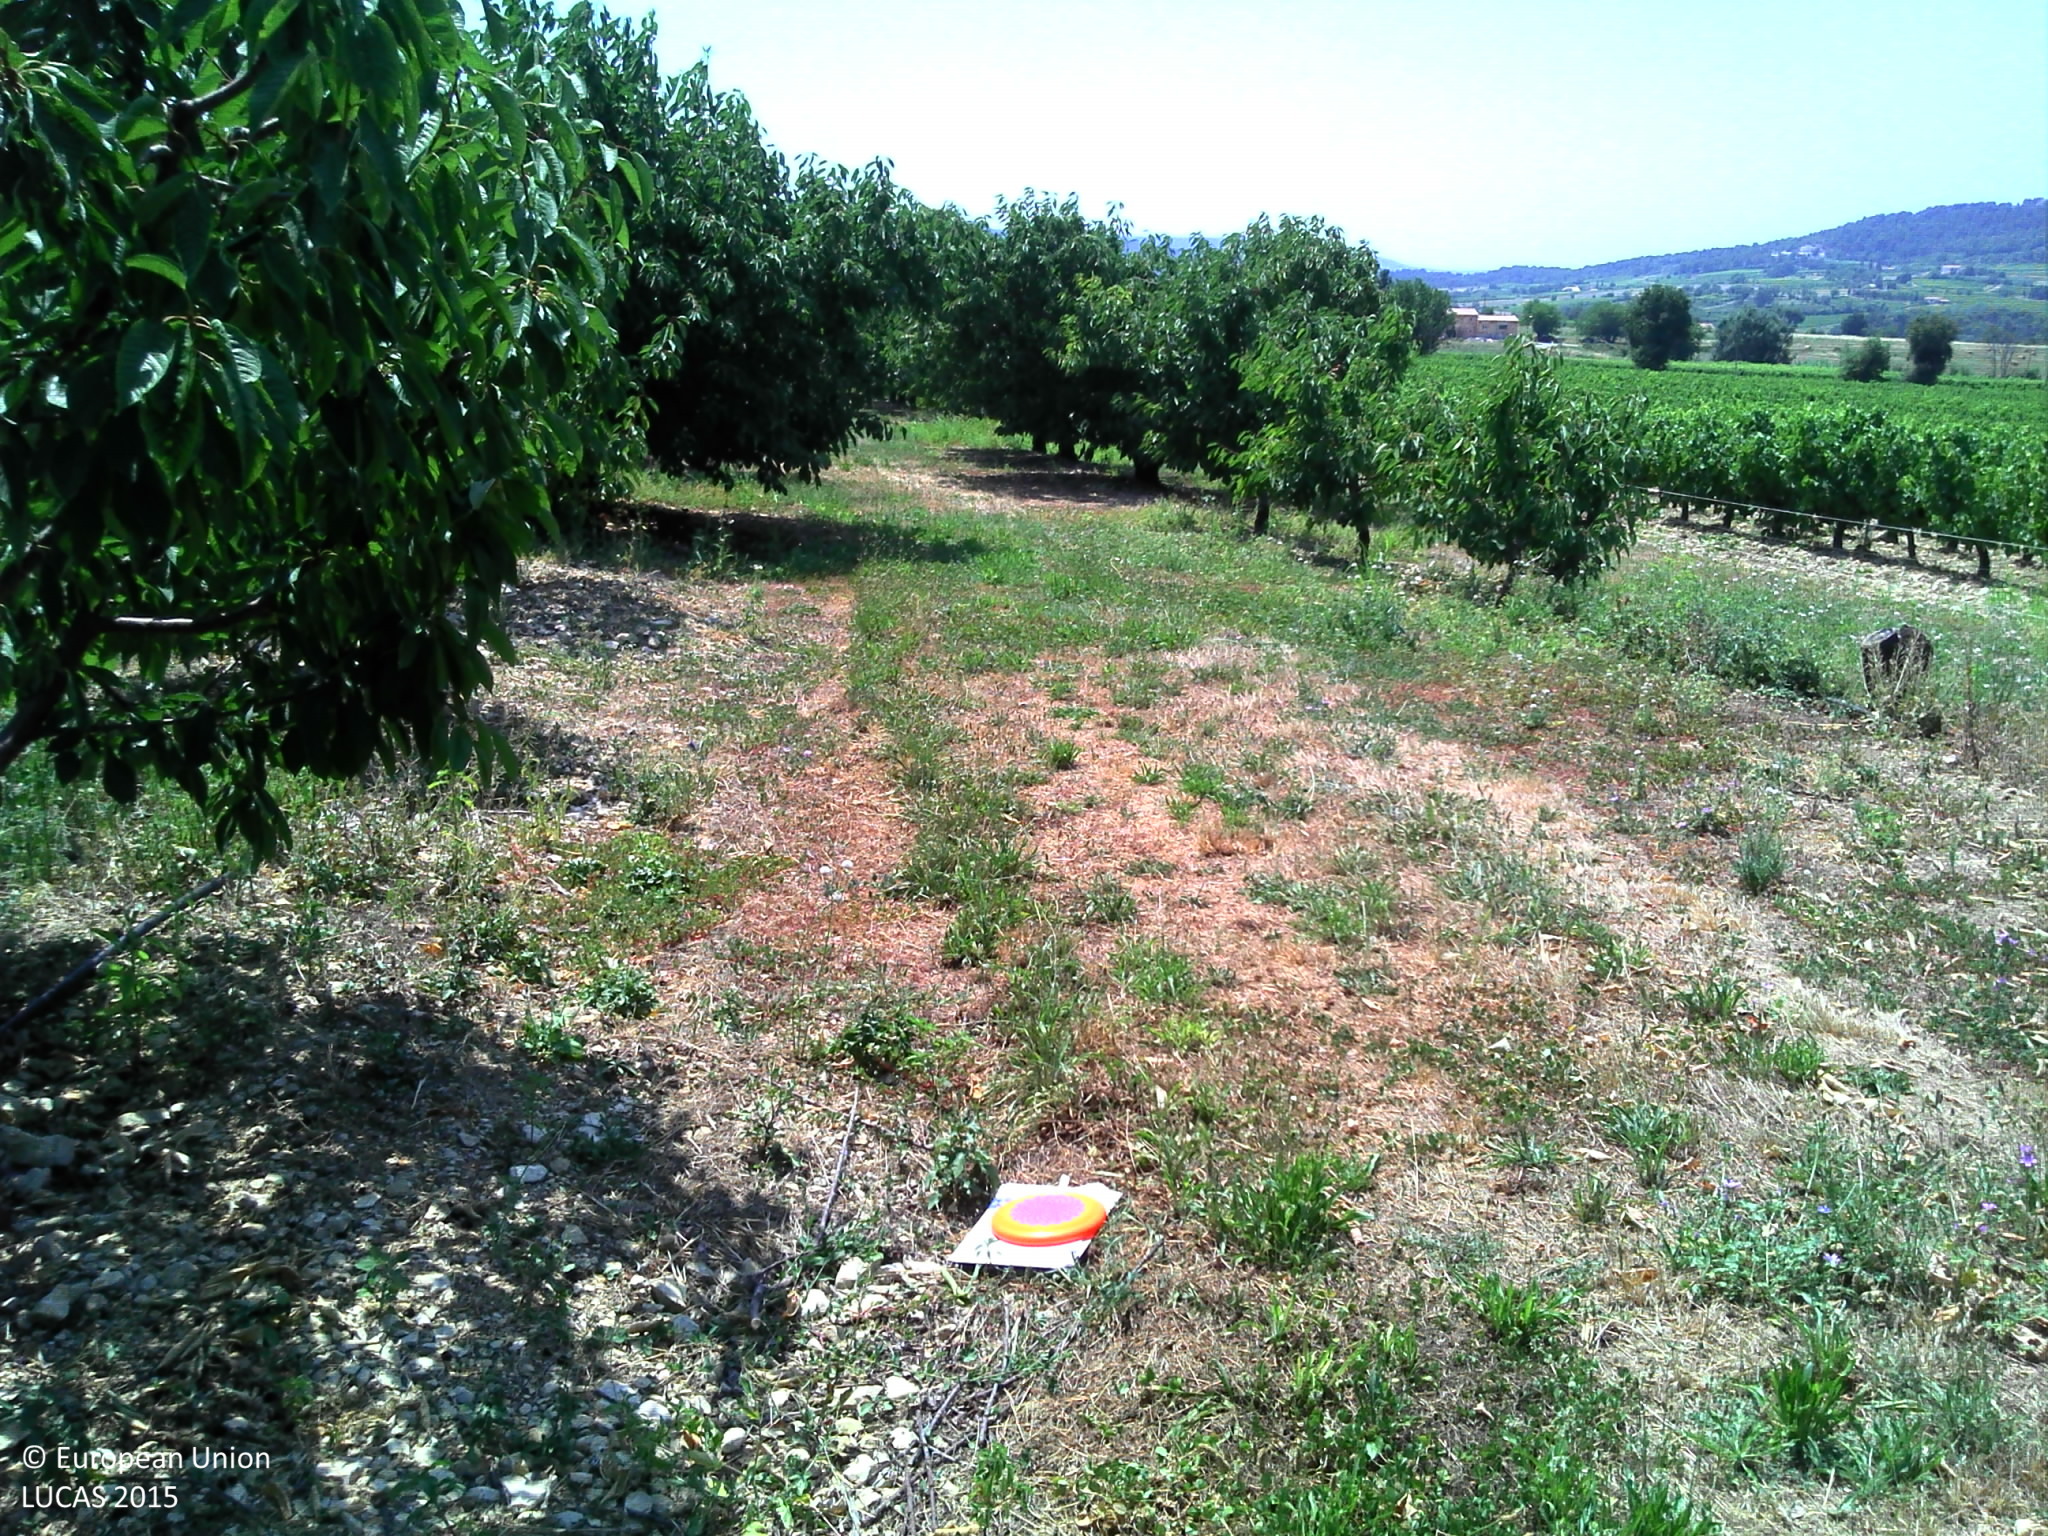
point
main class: Cropland
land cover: Cherry fruit
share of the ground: 50 - 75 %
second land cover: Grassland without tree/shrub cover
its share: 50 - 75 %
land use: Agriculture (excluding fallow land and kitchen gardens)
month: July
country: FR
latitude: 44.0421
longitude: 5.2286
